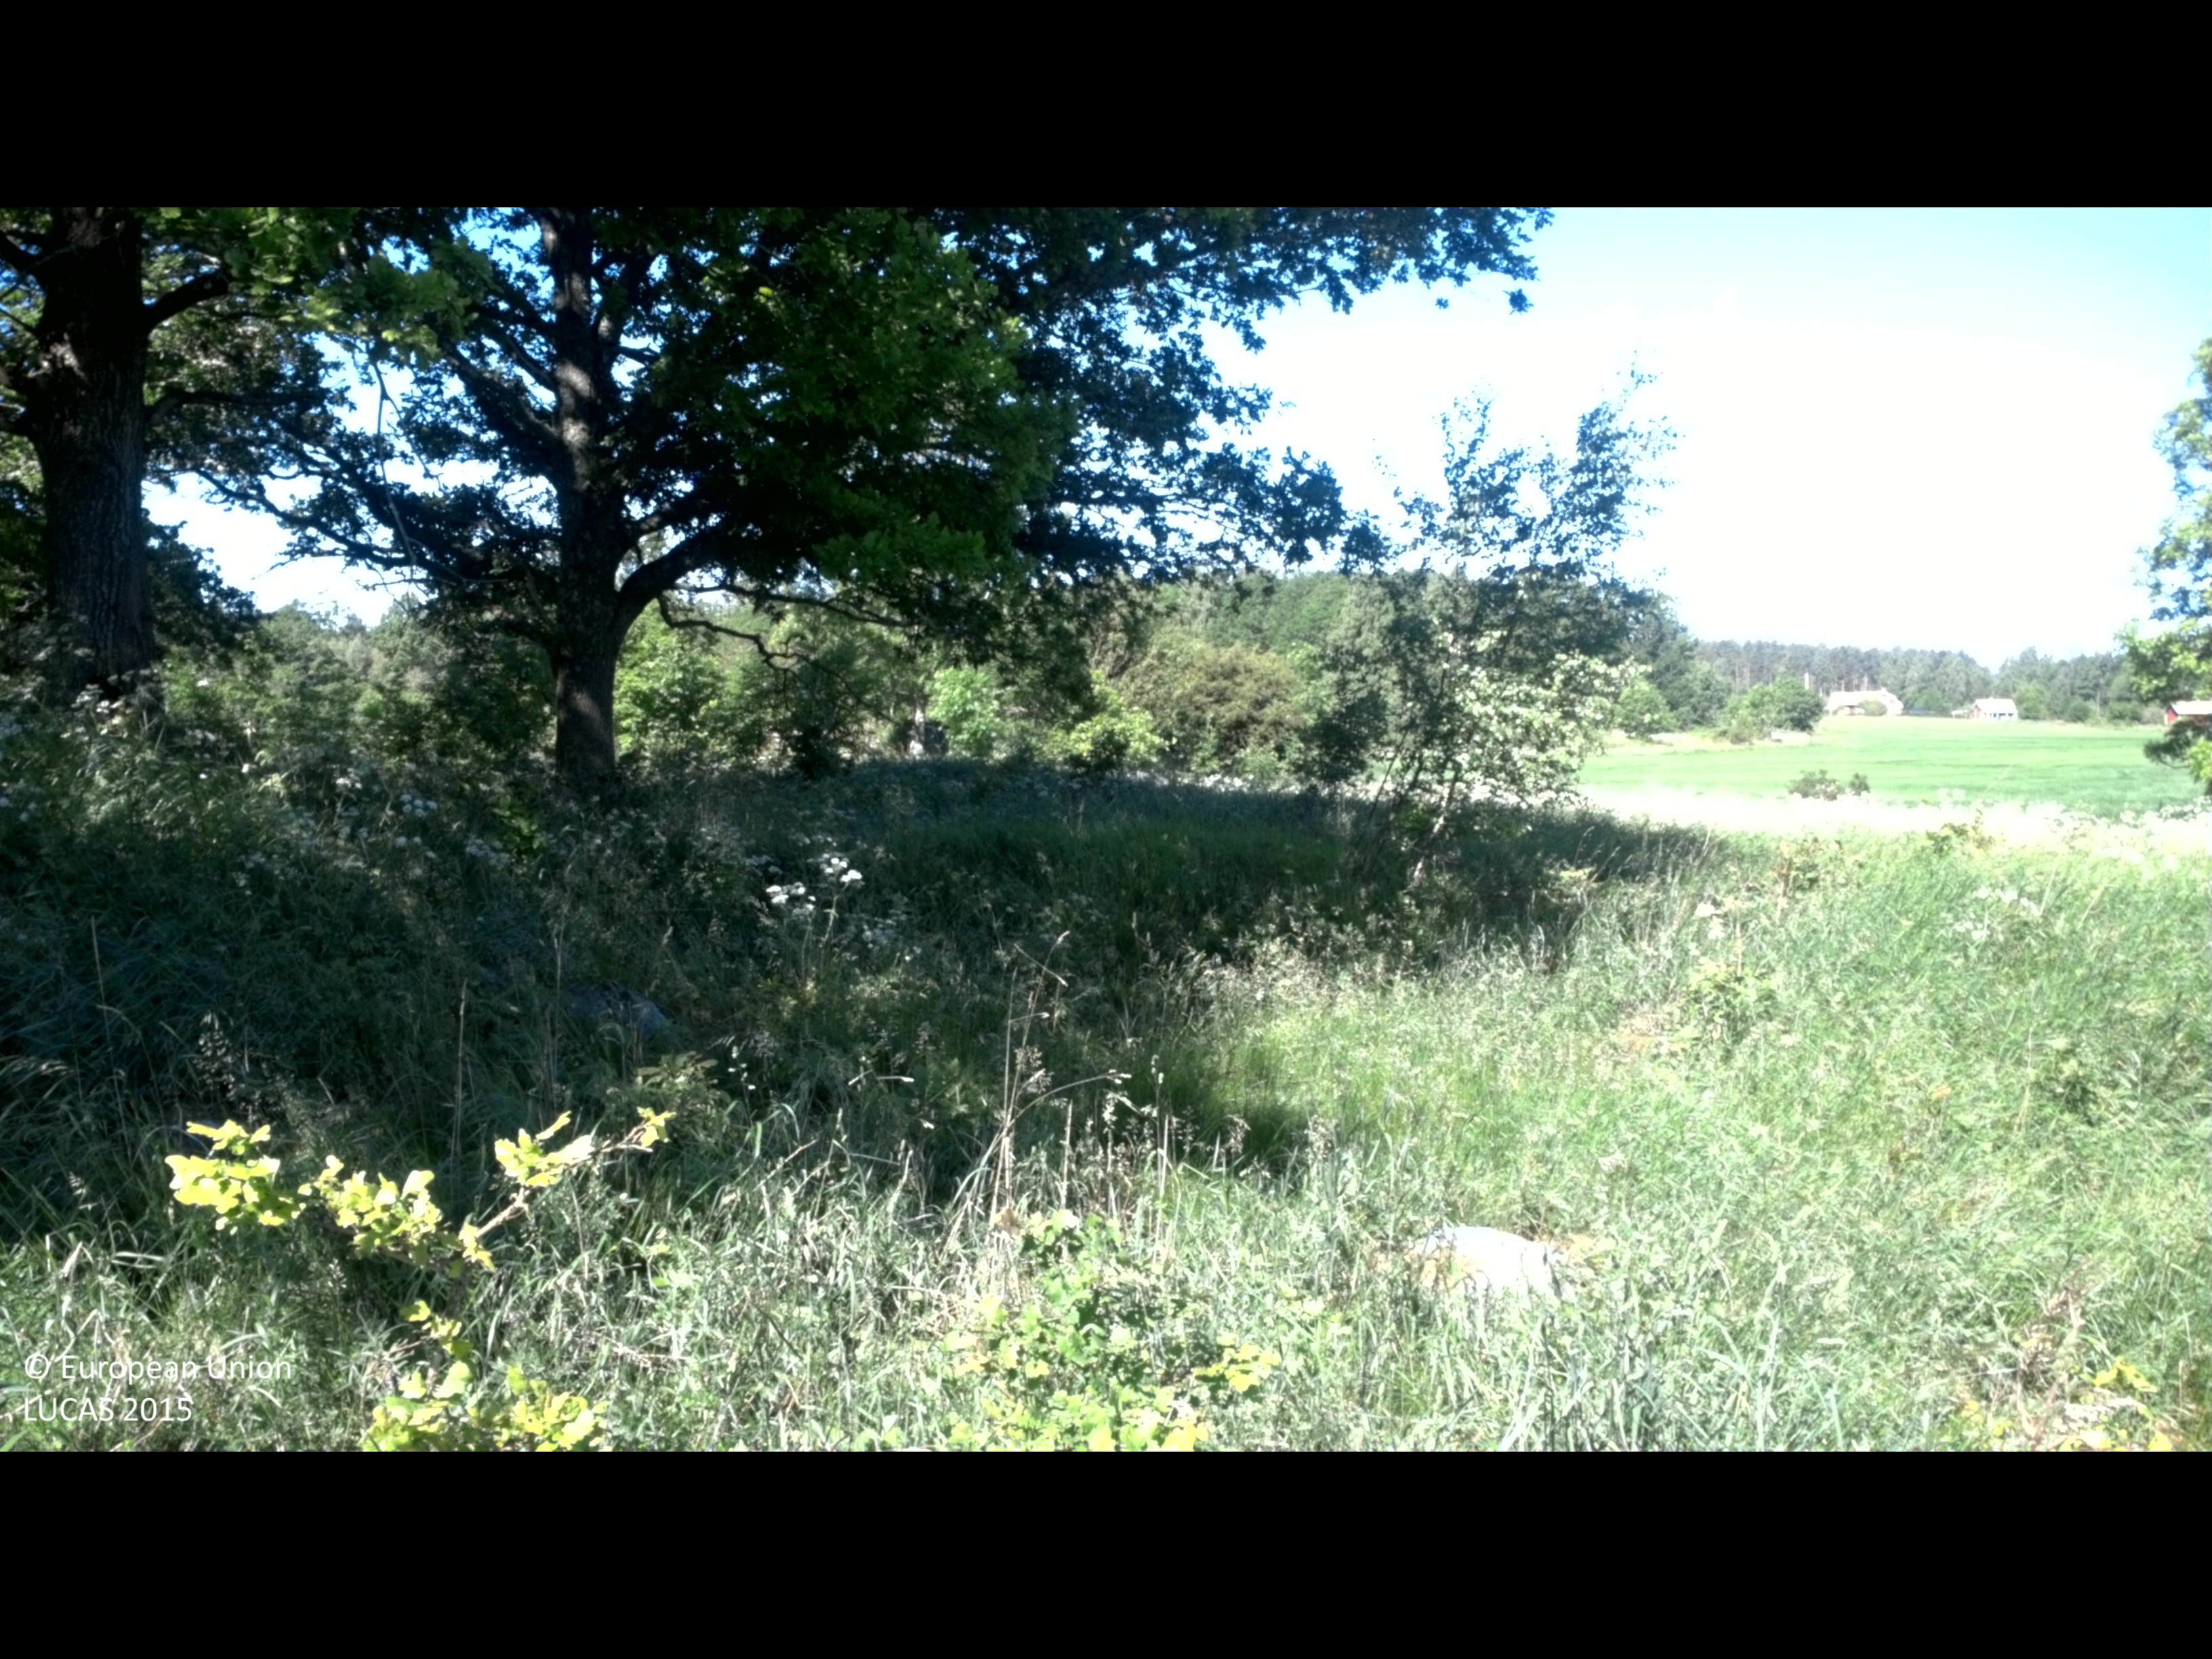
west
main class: Woodland
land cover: Broadleaved woodland
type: hemiboreal forest and nemoral coniferous forest and mixed broadleaved-coniferous forest
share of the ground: 50 - 75 %
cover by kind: broadleaved forest trees 75 %, herbaceous plants 20 %, shrubs 5 %
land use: Forestry
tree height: > 5 m
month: June
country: SE
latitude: 57.7308
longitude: 16.6323
